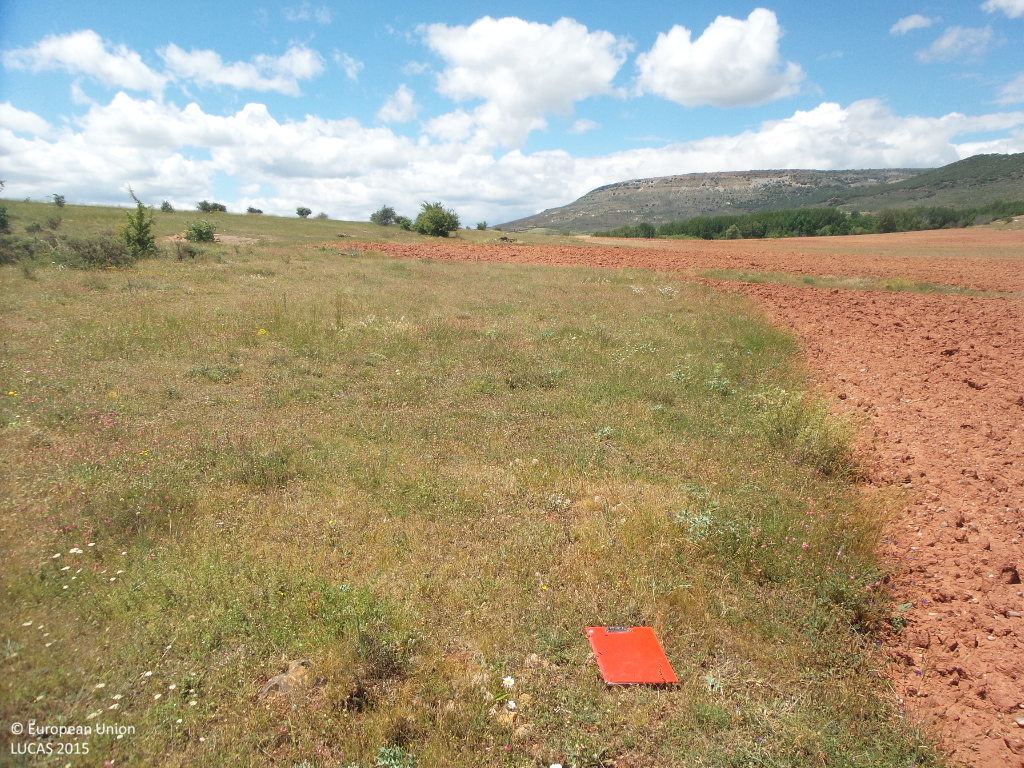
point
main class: Grassland
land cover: Spontaneously vegetated surfaces
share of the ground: > 75 %
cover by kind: herbaceous plants 95 %, shrubs 5 %
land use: Semi-natural and natural areas not in use
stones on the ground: < 10 %
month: June
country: ES
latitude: 41.2476
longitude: -2.9860
